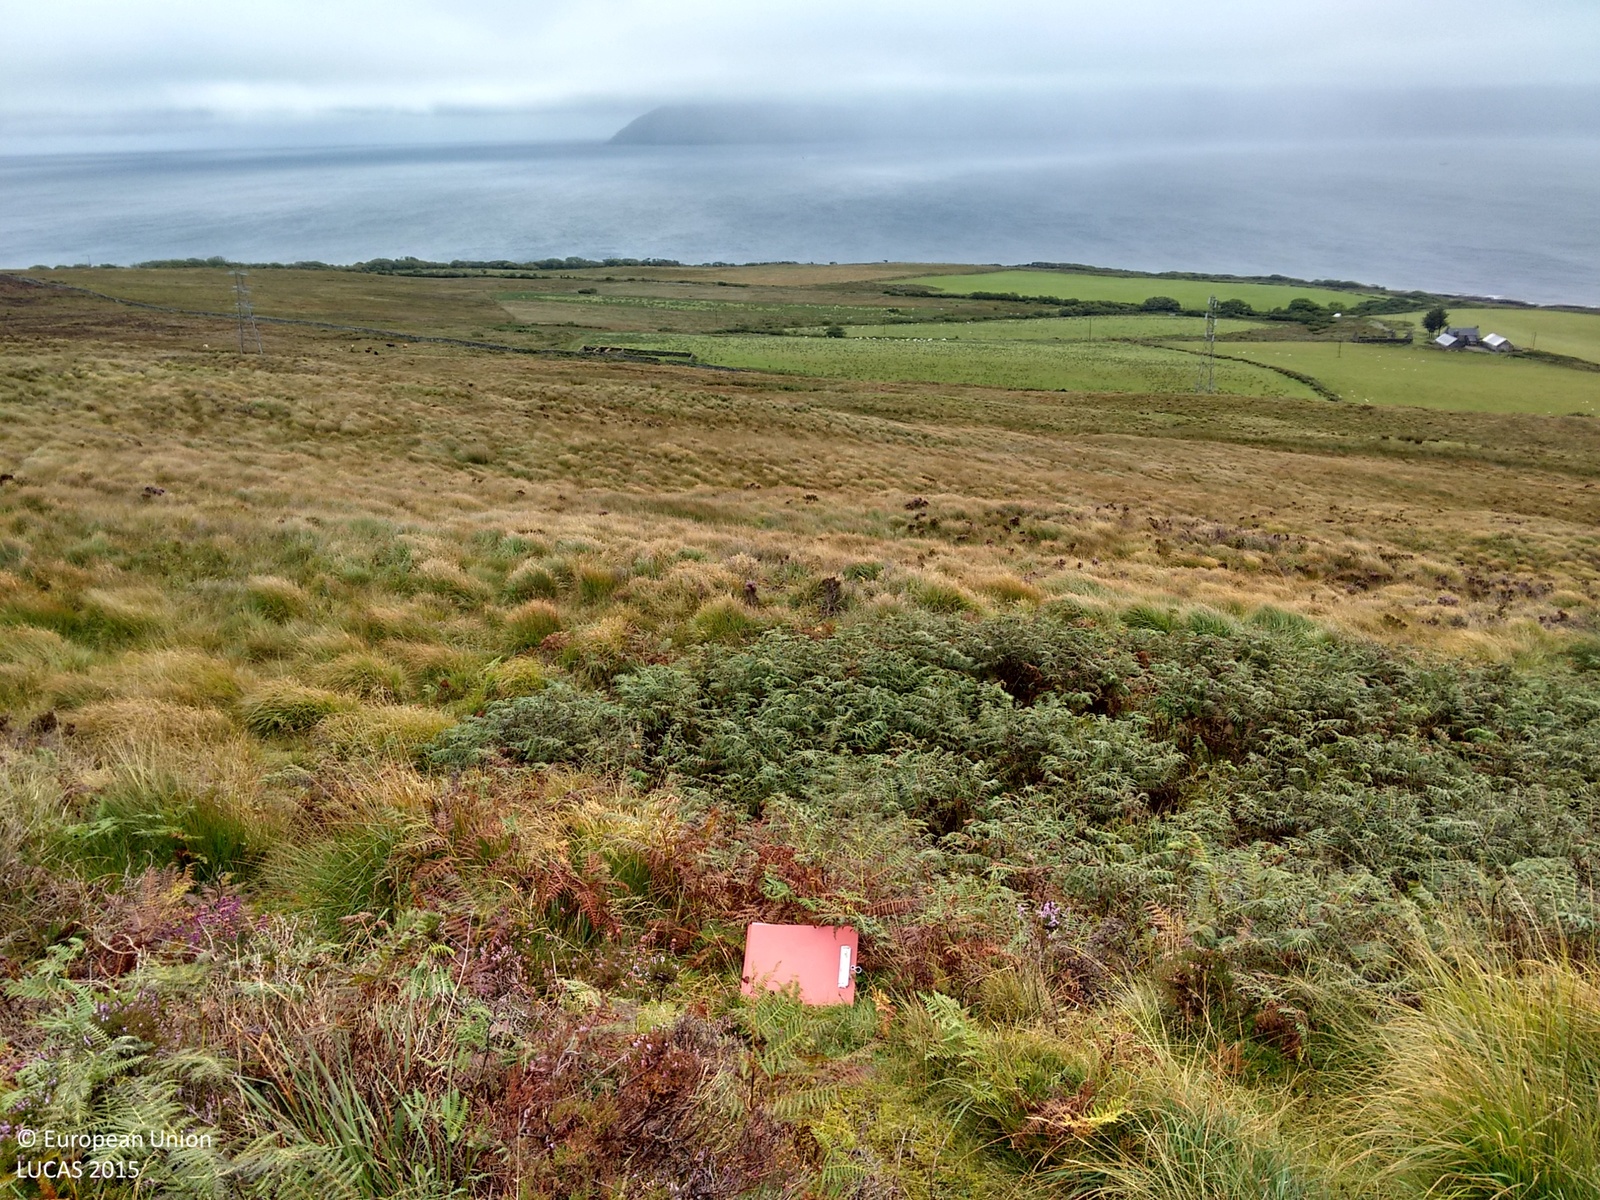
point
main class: Shrubland
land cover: Shrubland without tree cover
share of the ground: > 75 %
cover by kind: herbaceous plants 70 %, shrubs 30 %
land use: Agriculture (excluding fallow land and kitchen gardens)
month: September
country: GB
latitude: 55.7416
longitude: -5.4289
